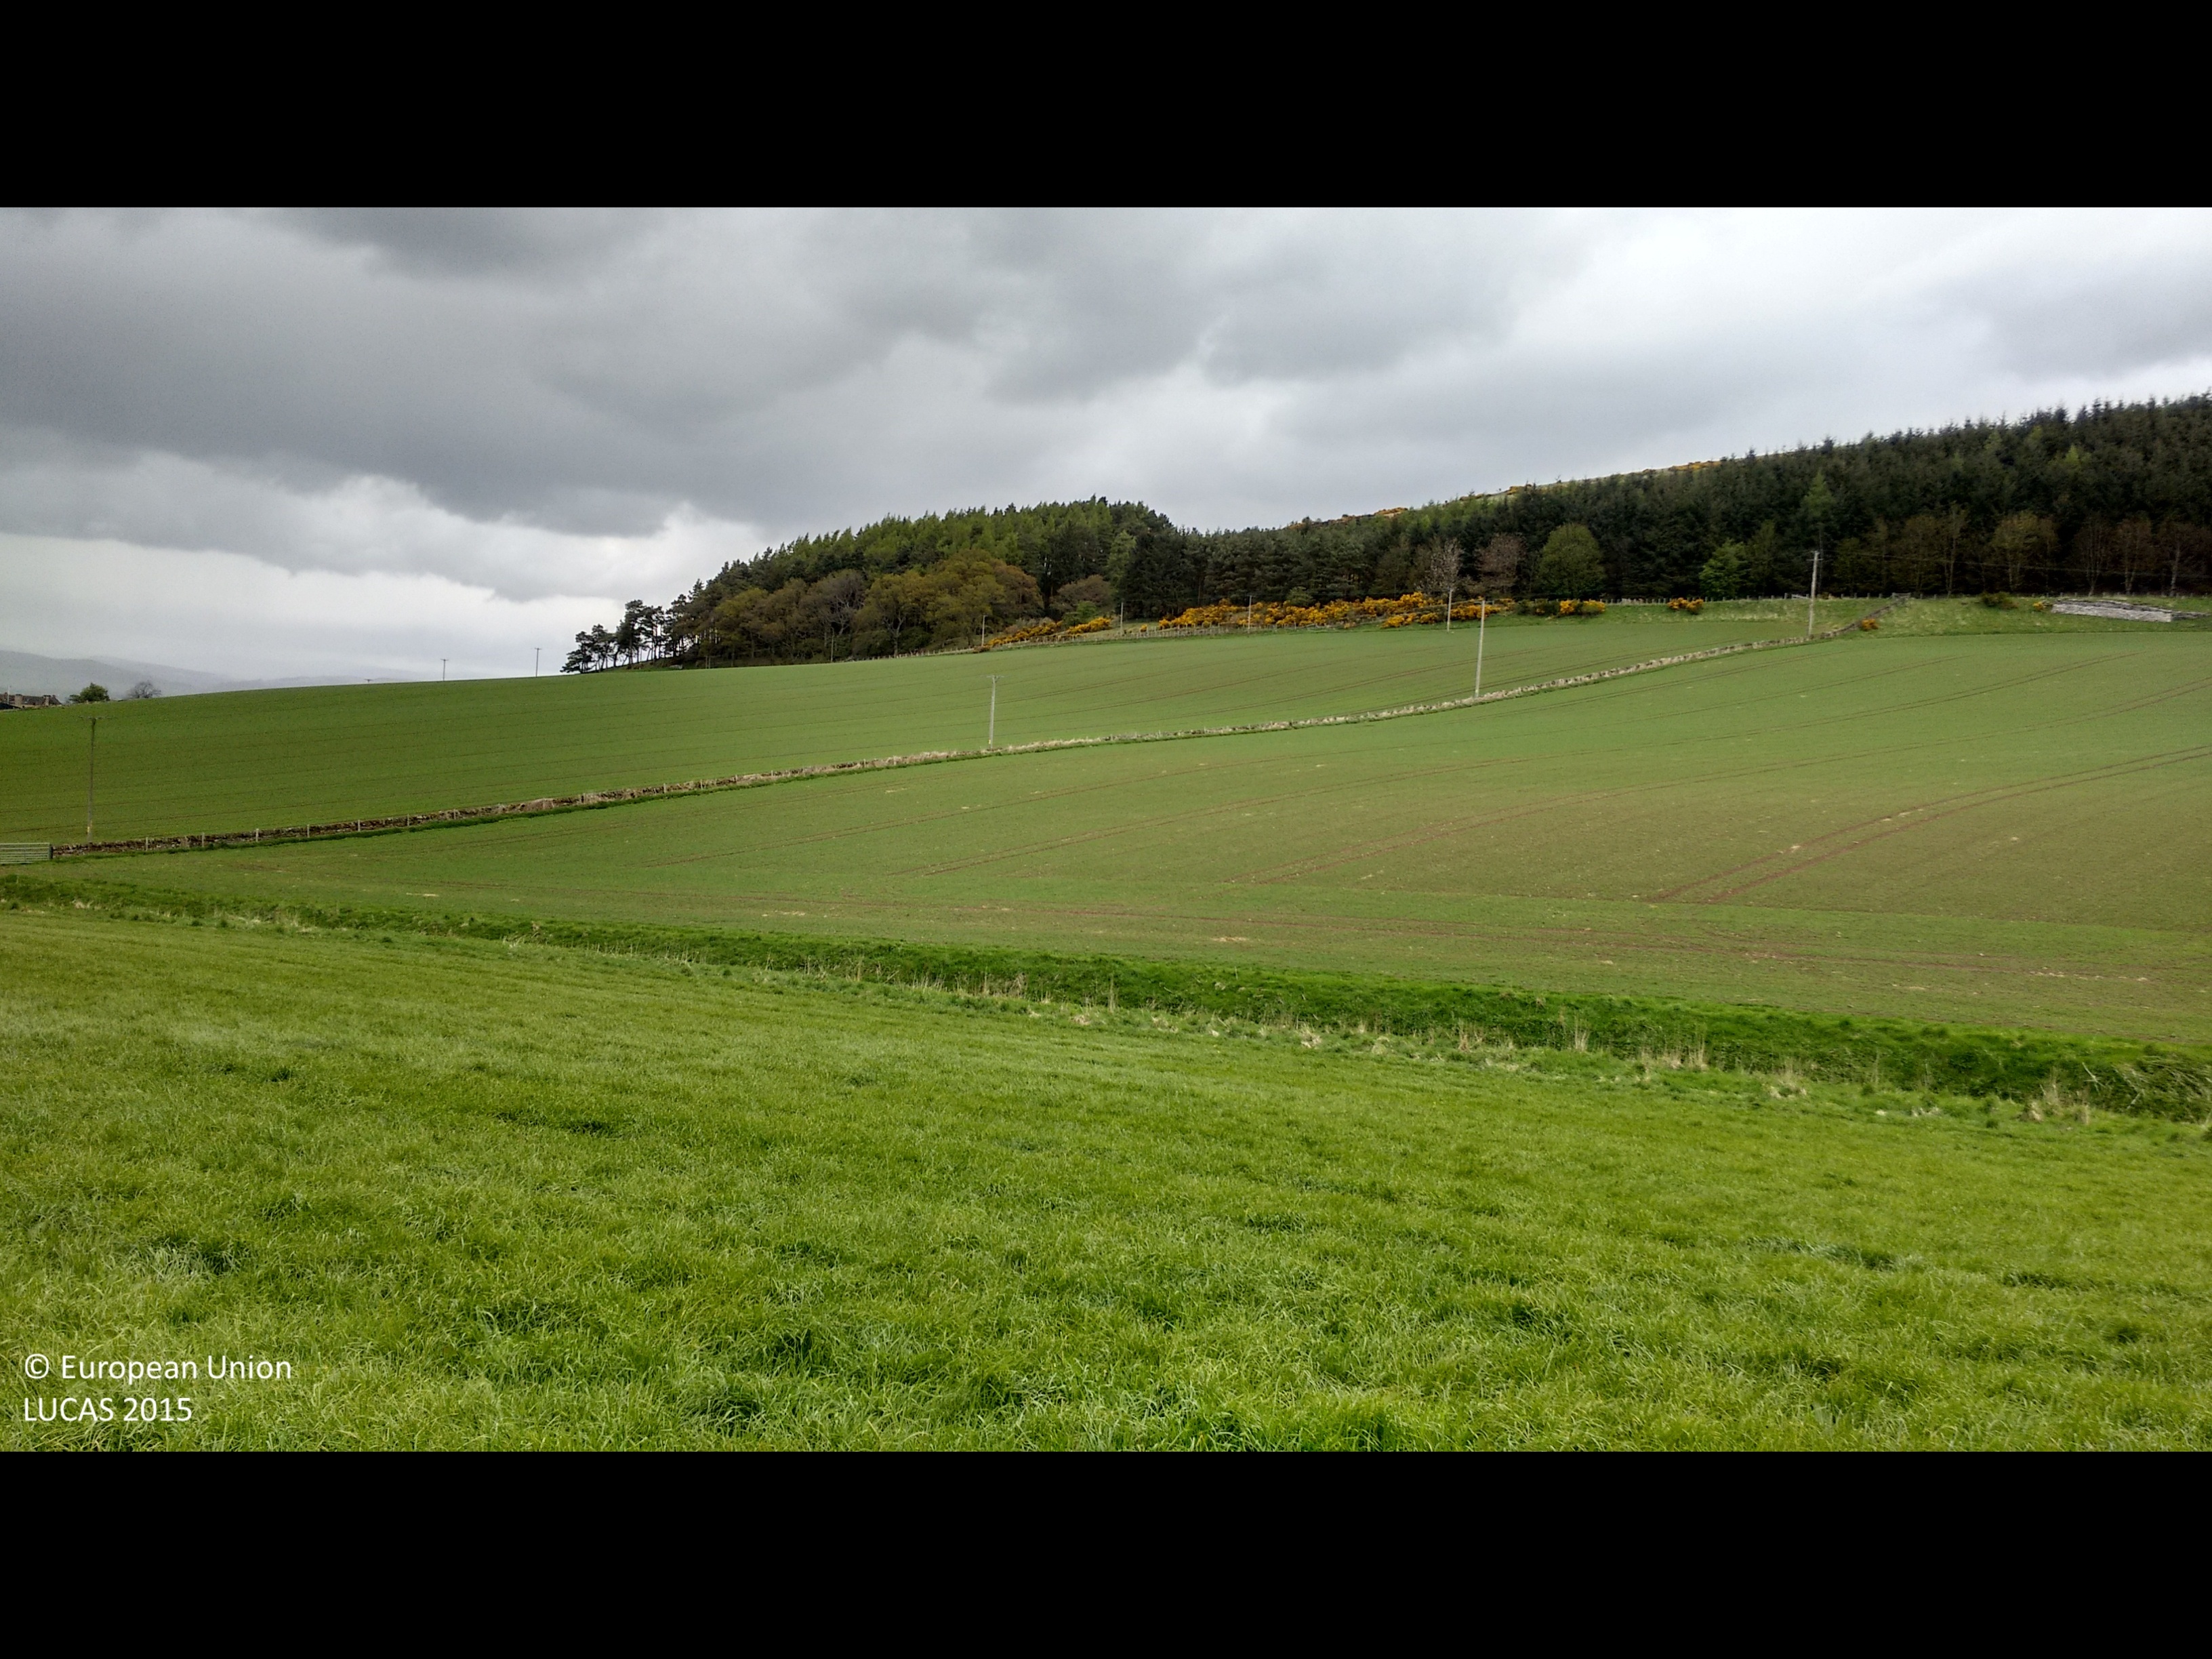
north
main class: Cropland
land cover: Temporary grasslands
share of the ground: > 75 %
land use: Agriculture (excluding fallow land and kitchen gardens)
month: May
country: GB
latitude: 56.5493
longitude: -3.1299
